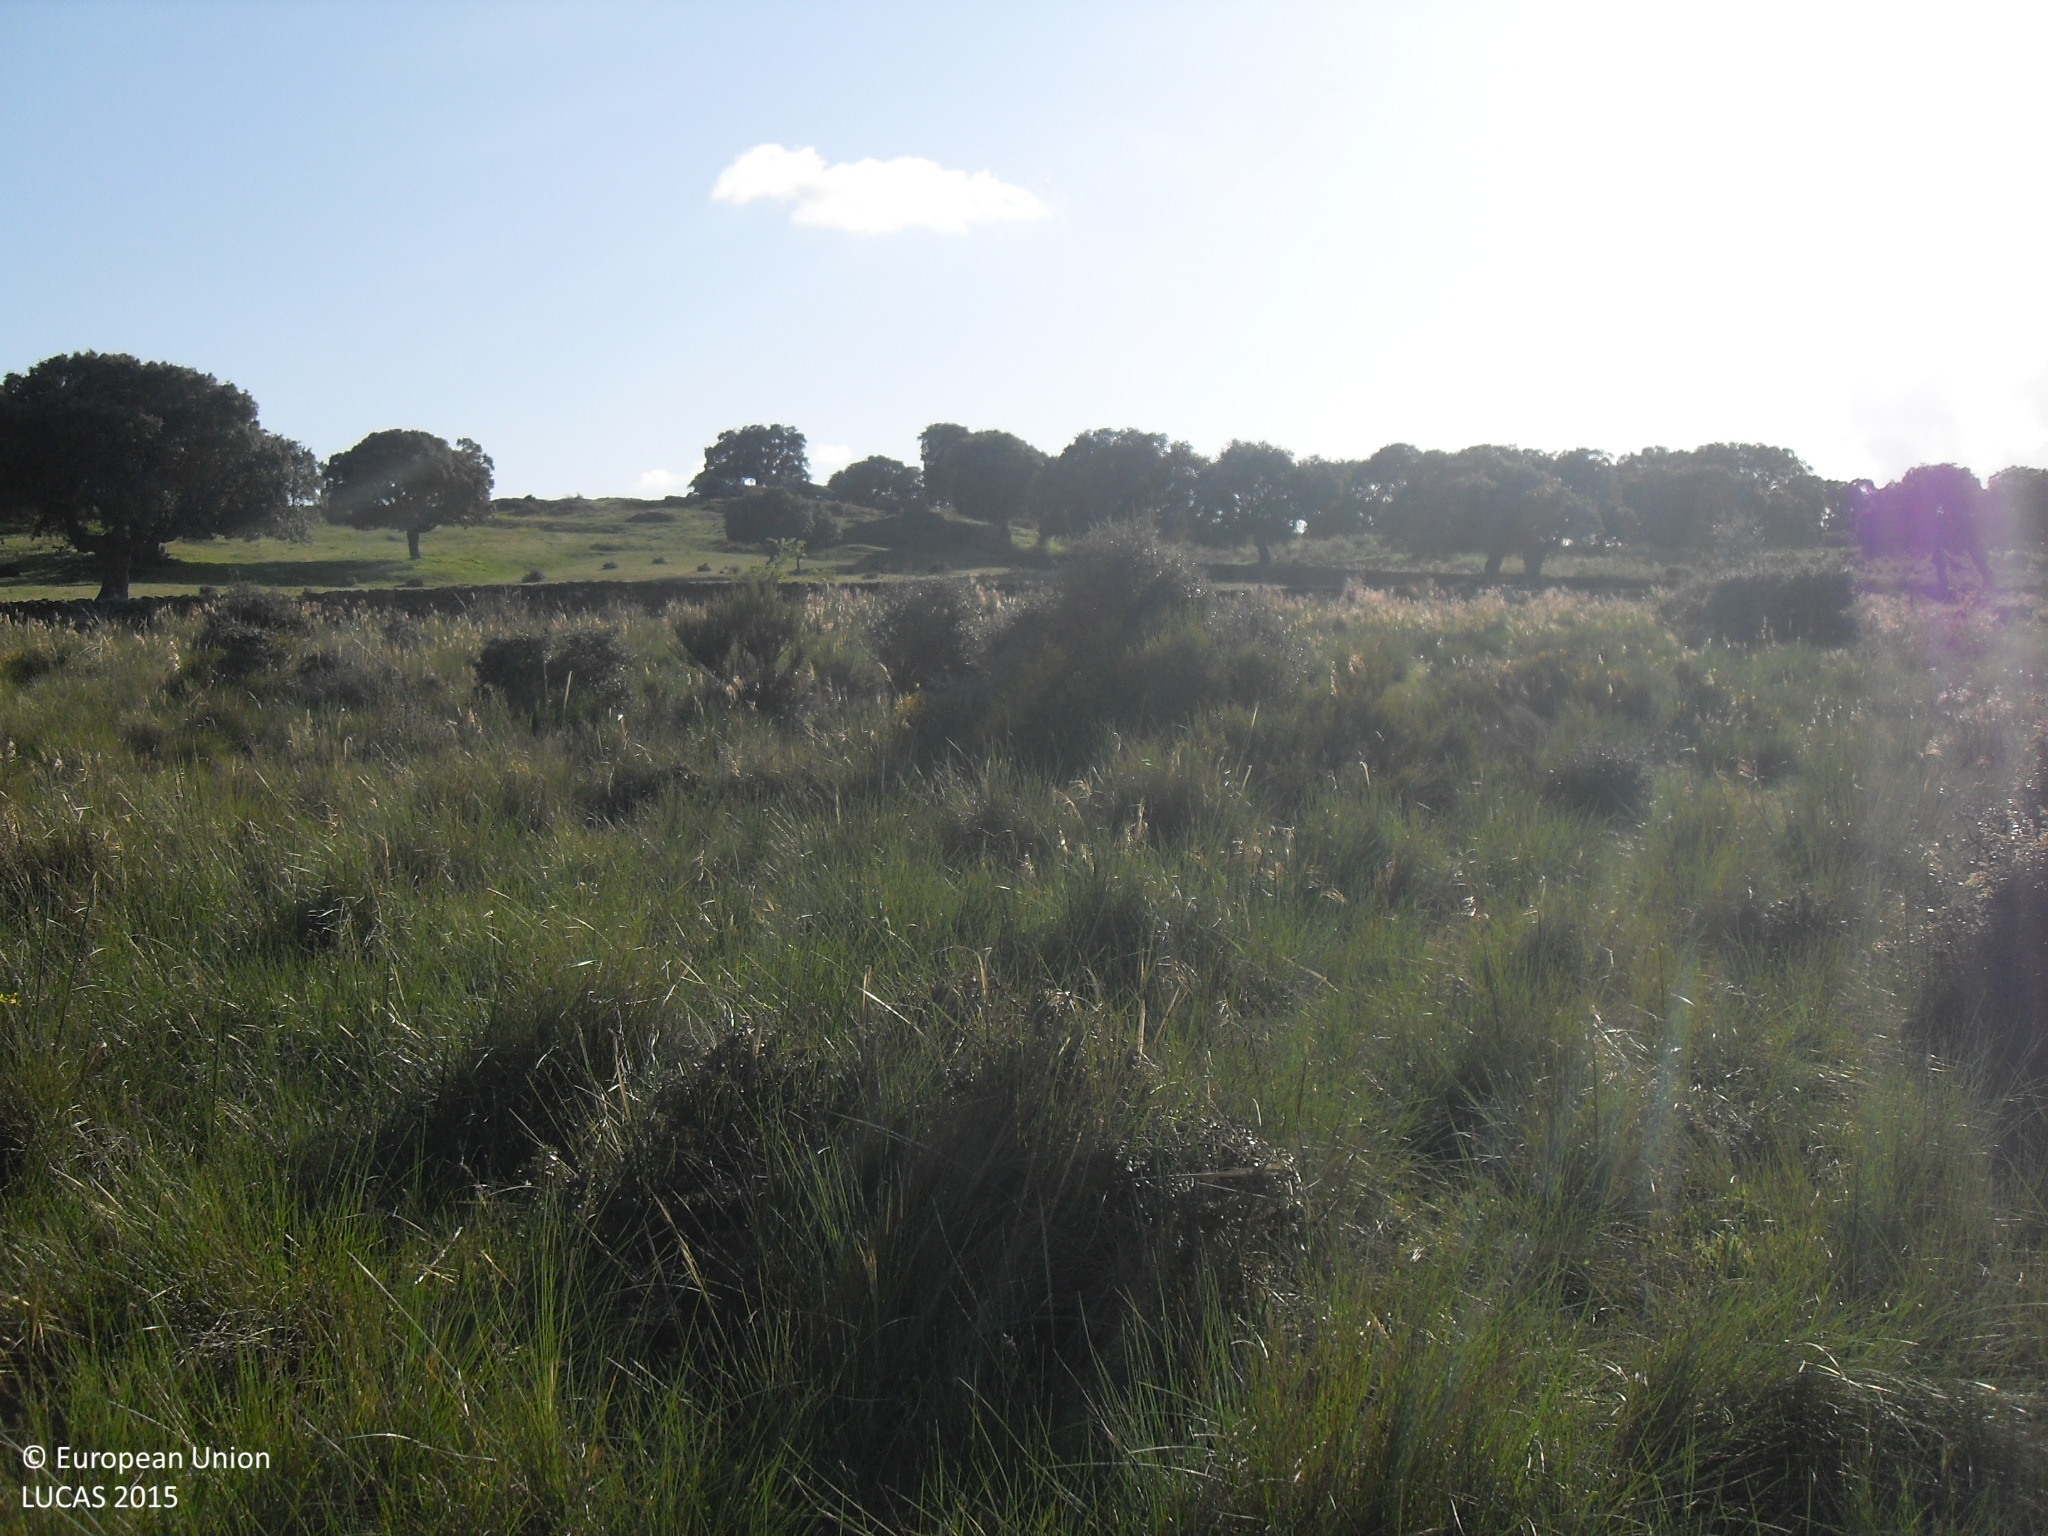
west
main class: Woodland
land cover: Broadleaved woodland
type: broadleaved evergreen forest
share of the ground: 10 - 25 %
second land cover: Grassland without tree/shrub cover
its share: > 75 %
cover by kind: herbaceous plants 80 %, broadleaved forest trees 20 %
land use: Forestry
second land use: Agriculture (excluding fallow land and kitchen gardens)
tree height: > 5 m
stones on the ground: < 10 %
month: May
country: ES
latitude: 40.6558
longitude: -5.3114
